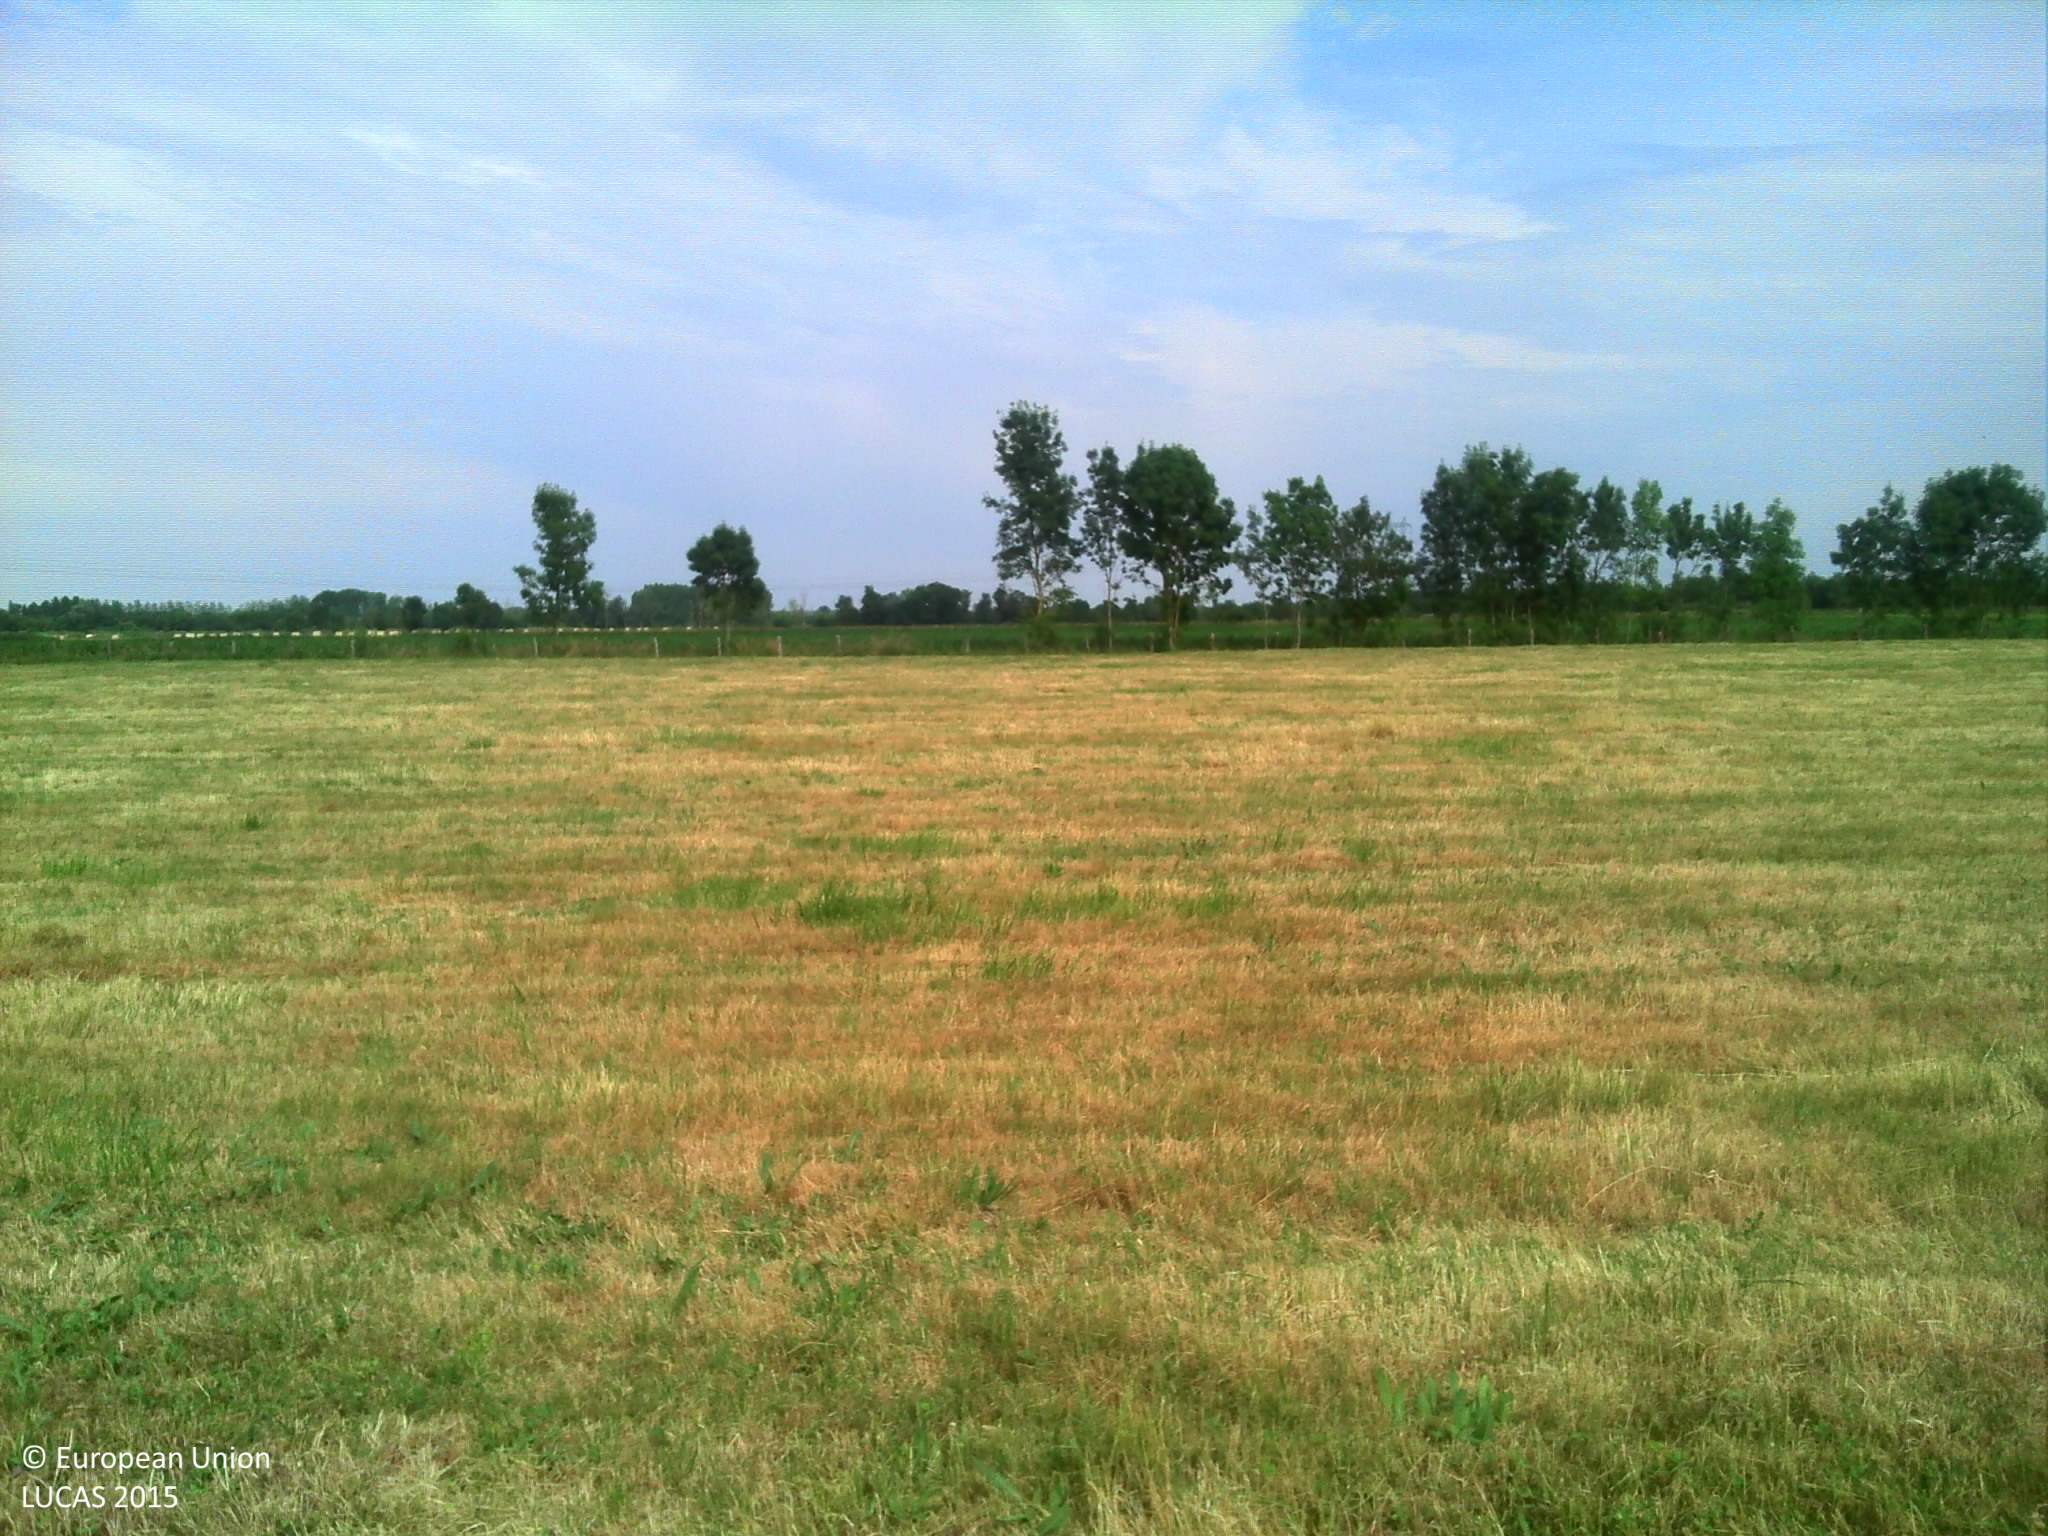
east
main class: Grassland
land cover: Grassland without tree/shrub cover
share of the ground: > 75 %
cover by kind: herbaceous plants 100 %
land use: Agriculture (excluding fallow land and kitchen gardens)
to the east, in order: Grassland without tree/shrub cover; Fences; Ditches and canals; Maize; Ditches and canals; Maize; Ditches and canals; Maize; Ditches and canals; Maize; Ditches and canals; Maize; Grass margins; Inland fresh running water; Grassland without tree/shrub cover
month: June
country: FR
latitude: 45.8796
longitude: -0.7589
